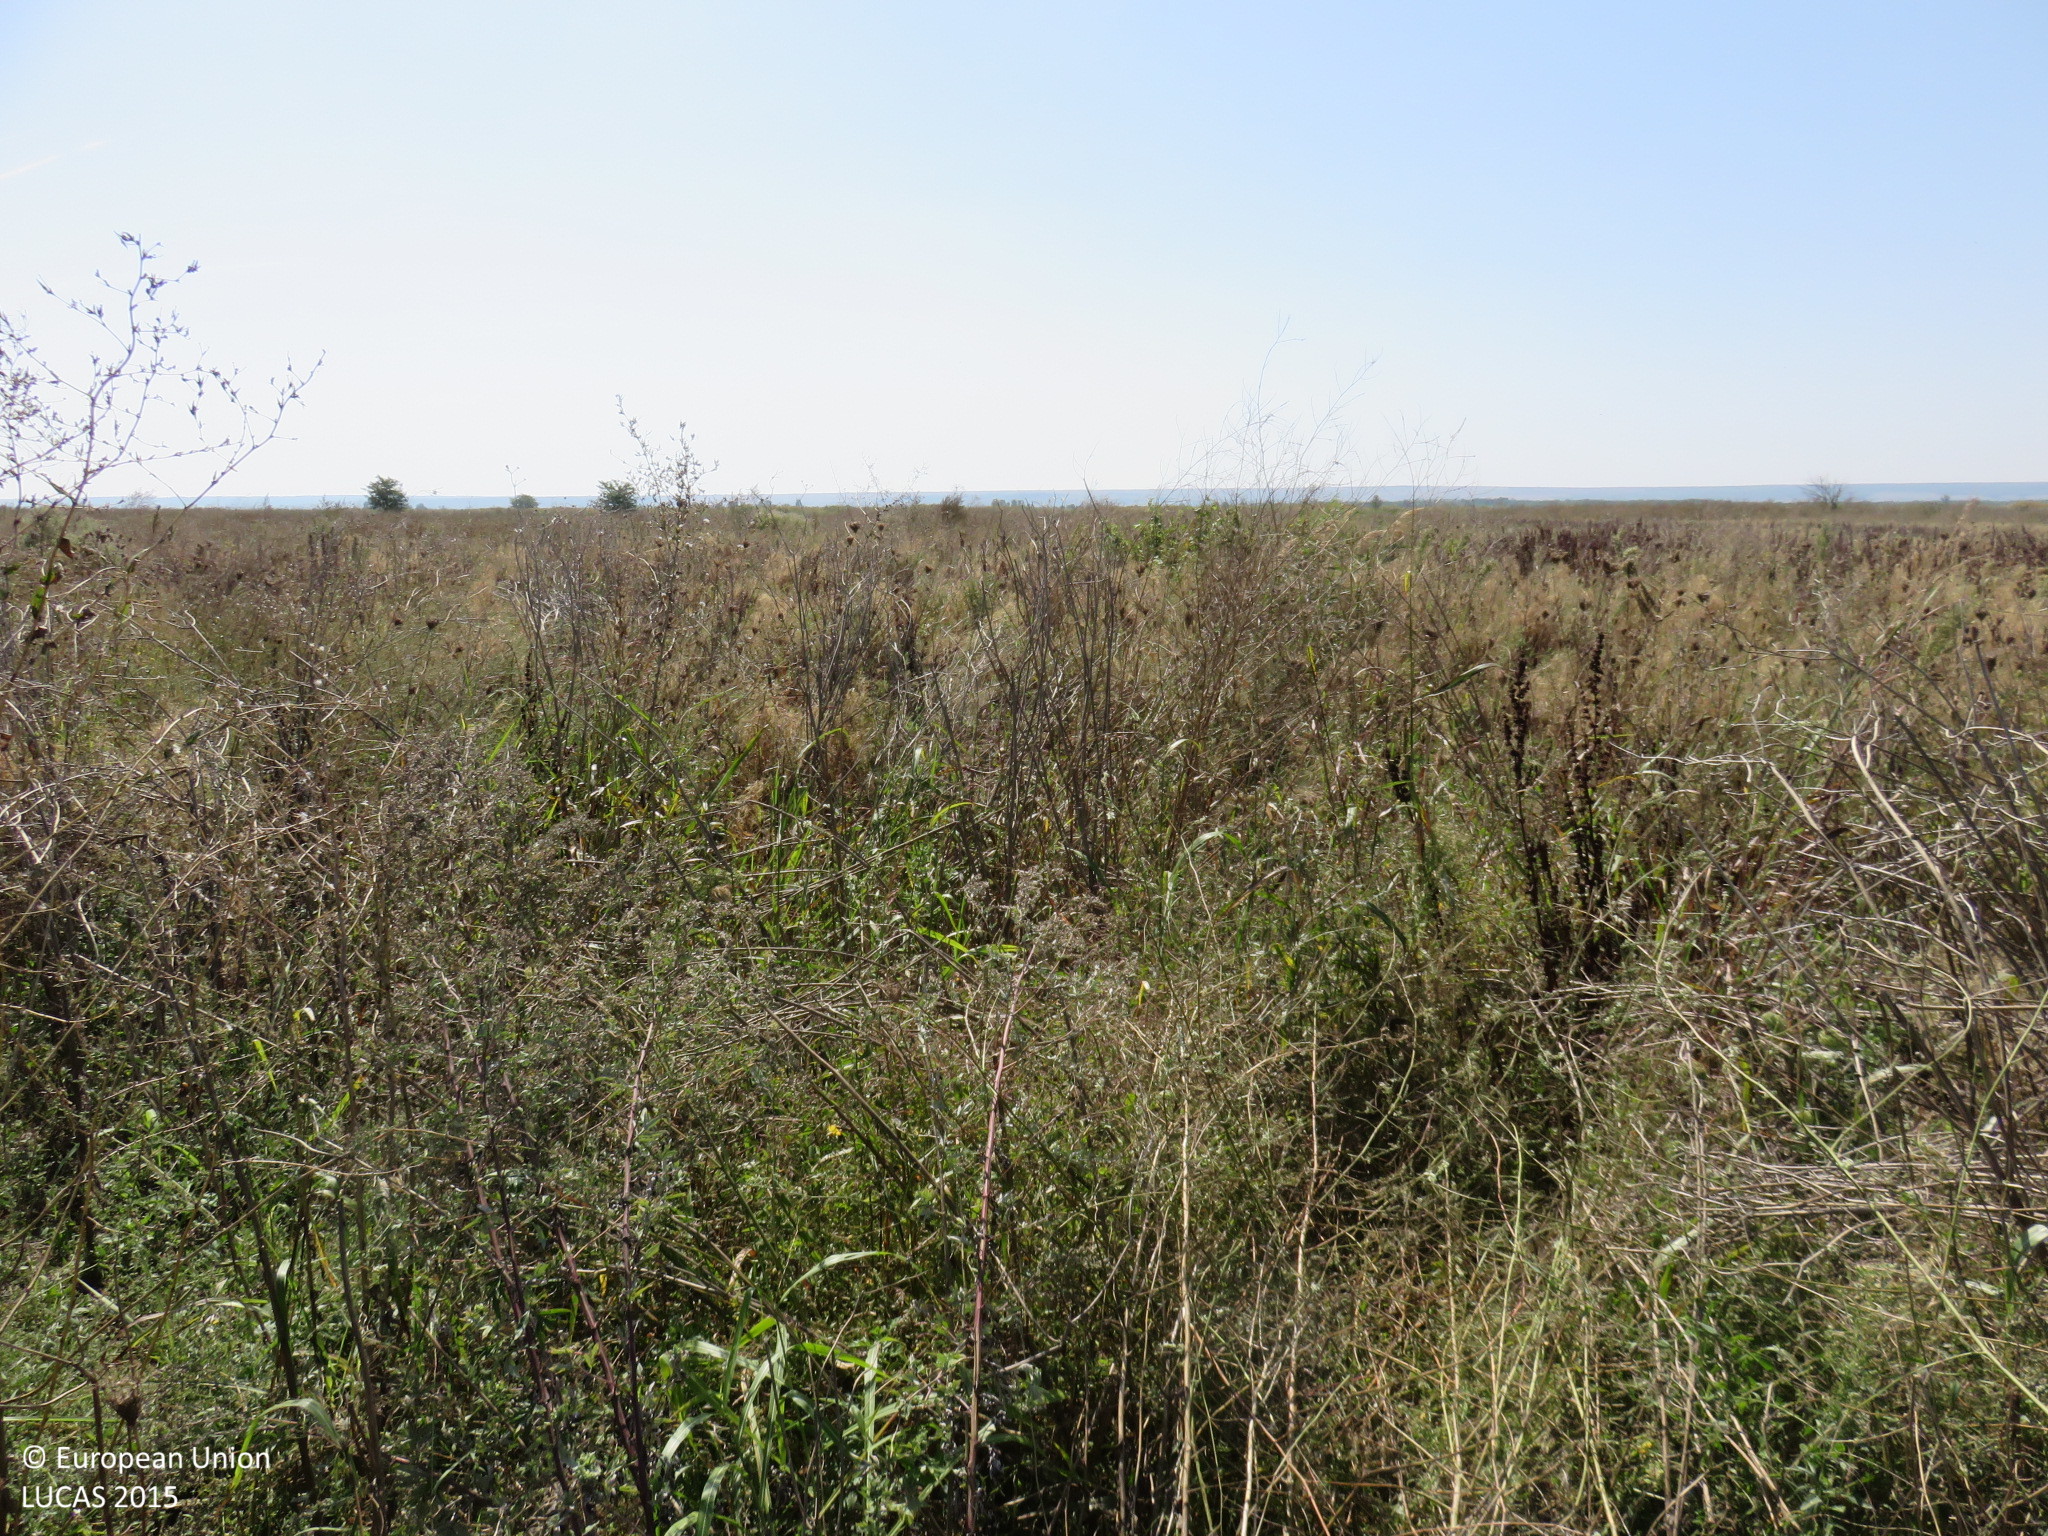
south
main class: Grassland
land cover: Spontaneously vegetated surfaces
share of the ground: > 75 %
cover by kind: herbaceous plants 100 %
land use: Agriculture (excluding fallow land and kitchen gardens)
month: September
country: BG
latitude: 43.7107
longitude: 24.6238
